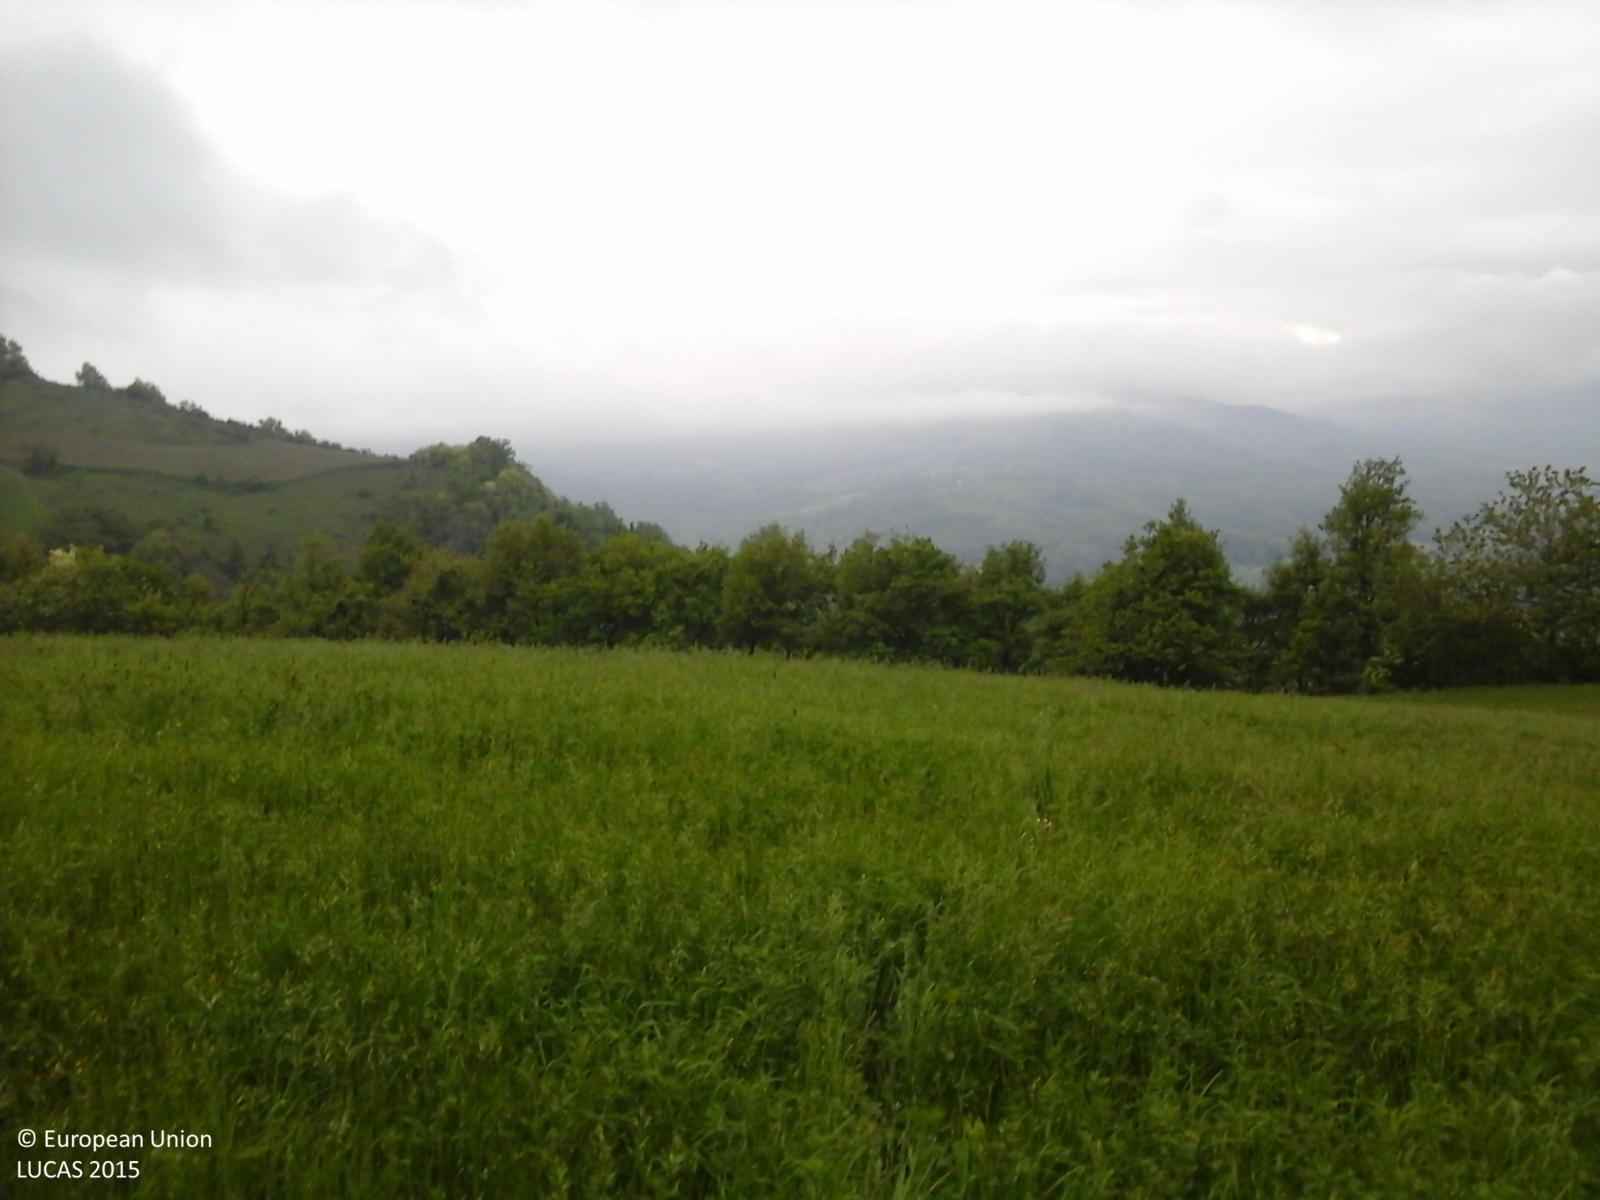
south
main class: Cropland
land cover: Other leguminous and mixtures for fodder
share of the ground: > 75 %
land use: Agriculture (excluding fallow land and kitchen gardens)
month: April
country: IT
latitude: 44.8897
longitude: 9.3808
